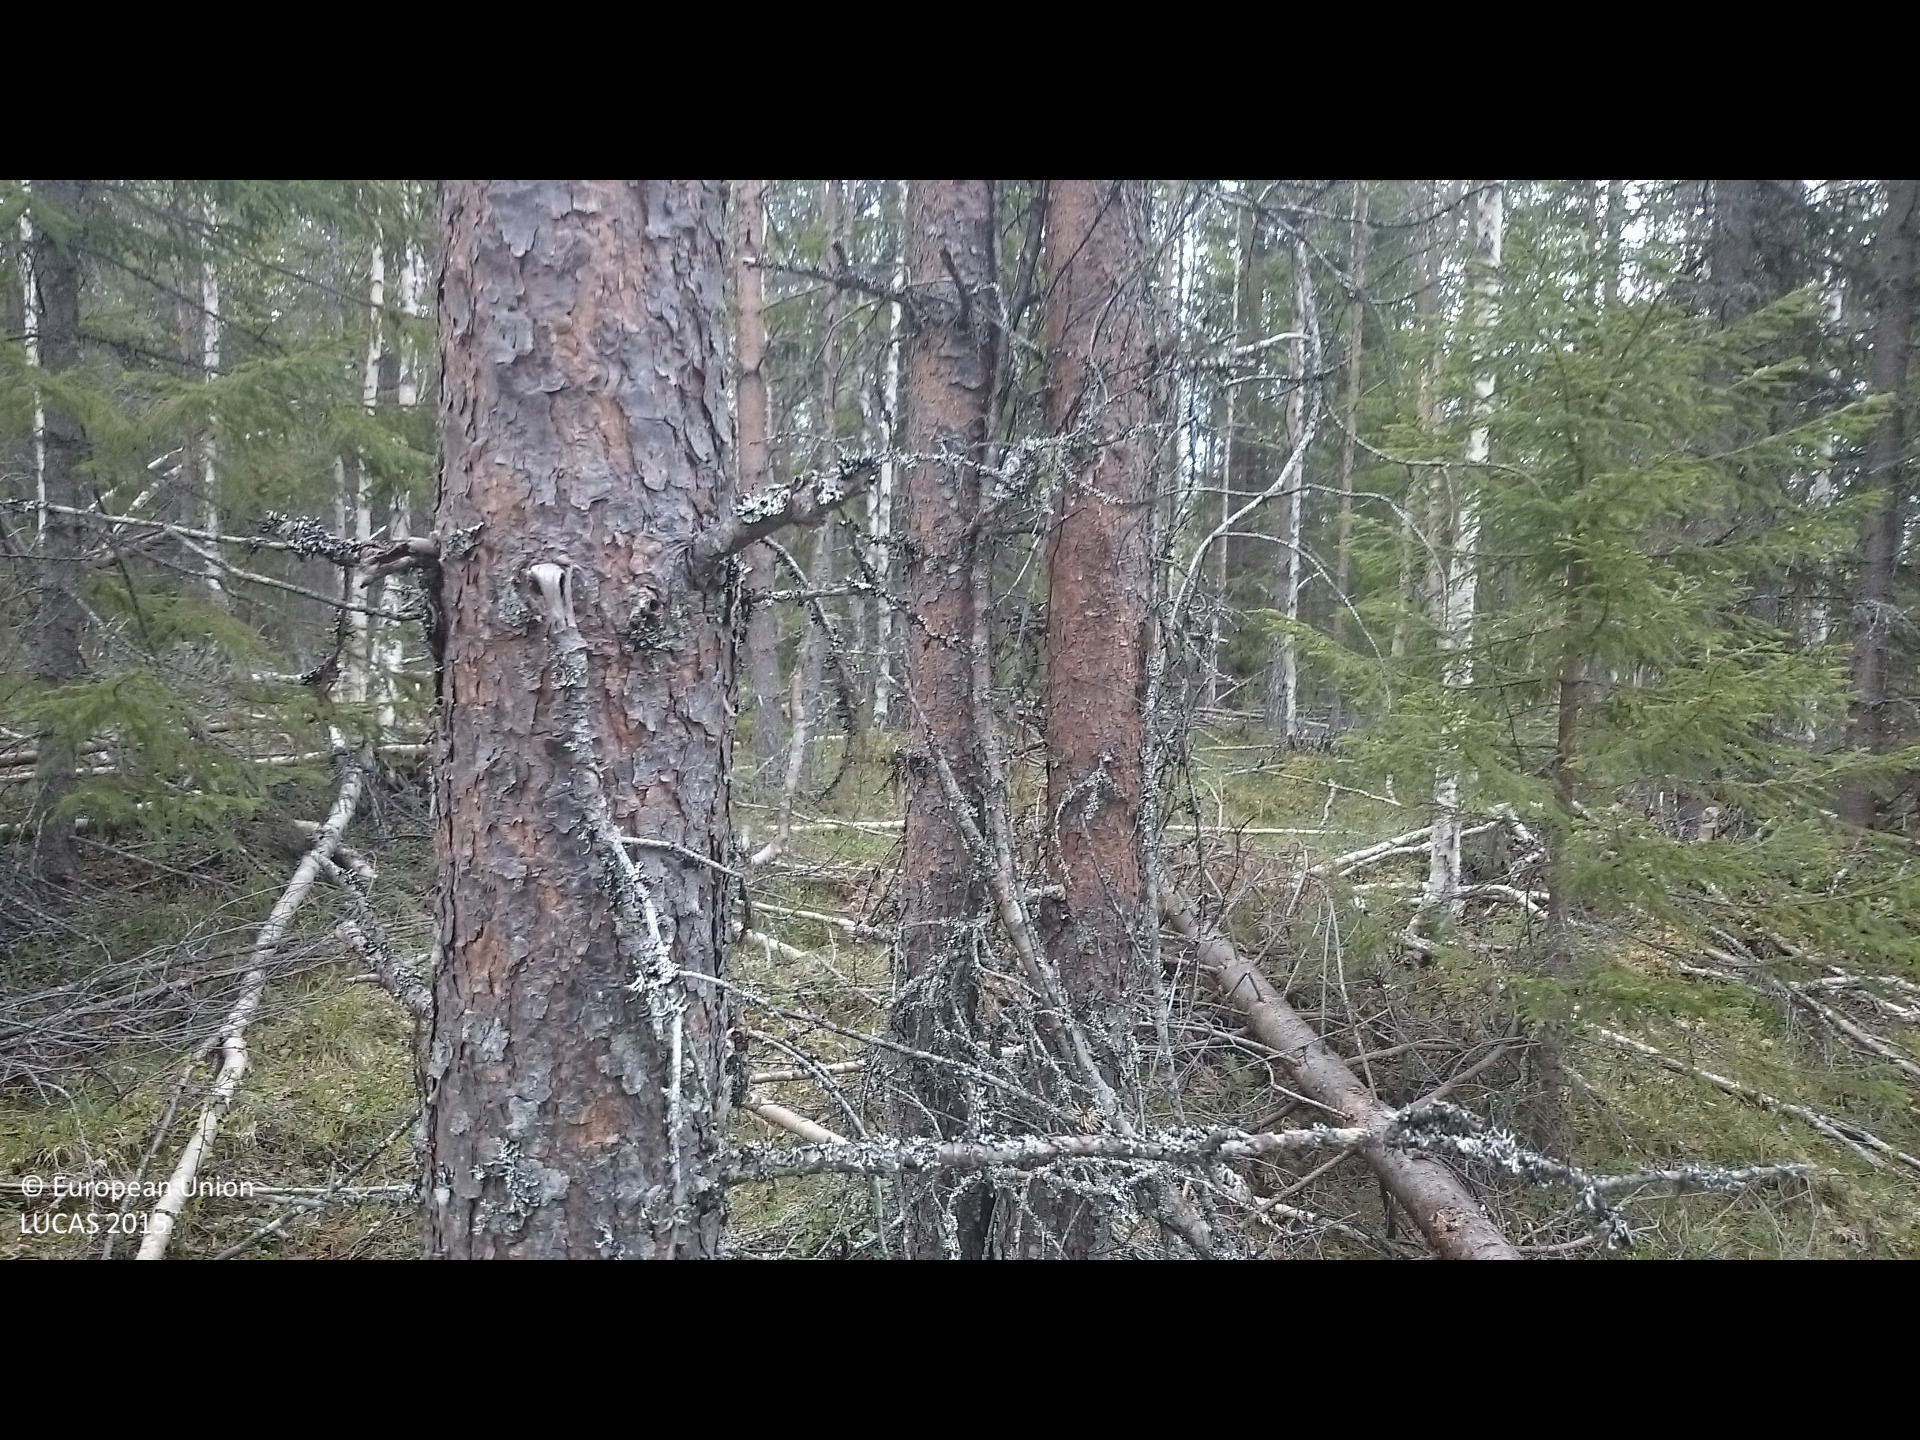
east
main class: Woodland
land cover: Pine dominated mixed woodland
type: boreal forest
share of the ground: > 75 %
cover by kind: coniferous forest trees 60 %, broadleaved forest trees 20 %, shrubs 10 %, herbaceous plants 10 %
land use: Forestry
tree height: > 5 m
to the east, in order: Pine dominated mixed woodland; Broadleaved woodland; Spruce dominated mixed woodland; Inland marshes
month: June
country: SE
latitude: 63.5739
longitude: 13.8669
